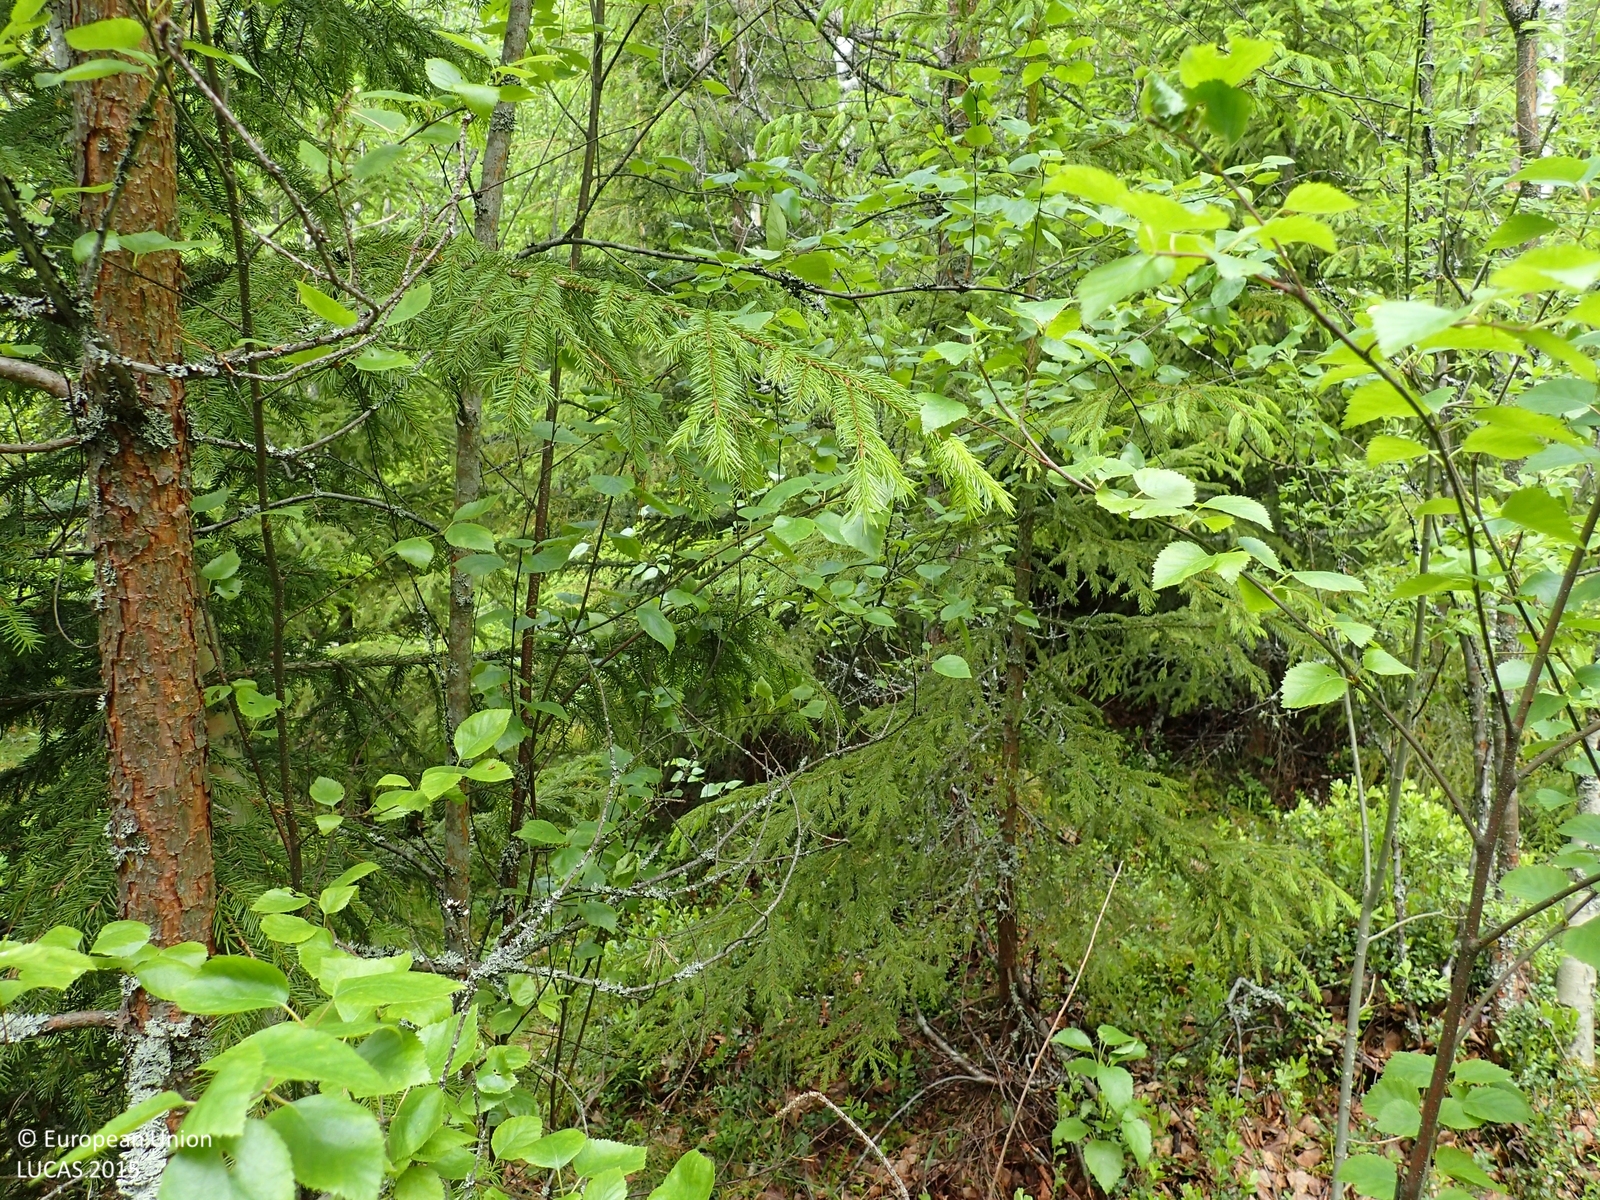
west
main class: Woodland
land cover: Other mixed woodland
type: boreal forest
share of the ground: > 75 %
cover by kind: broadleaved forest trees 45 %, coniferous forest trees 35 %, shrubs 20 %
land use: Forestry
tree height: > 5 m
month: June
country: FI
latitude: 62.3439
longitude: 21.3792
